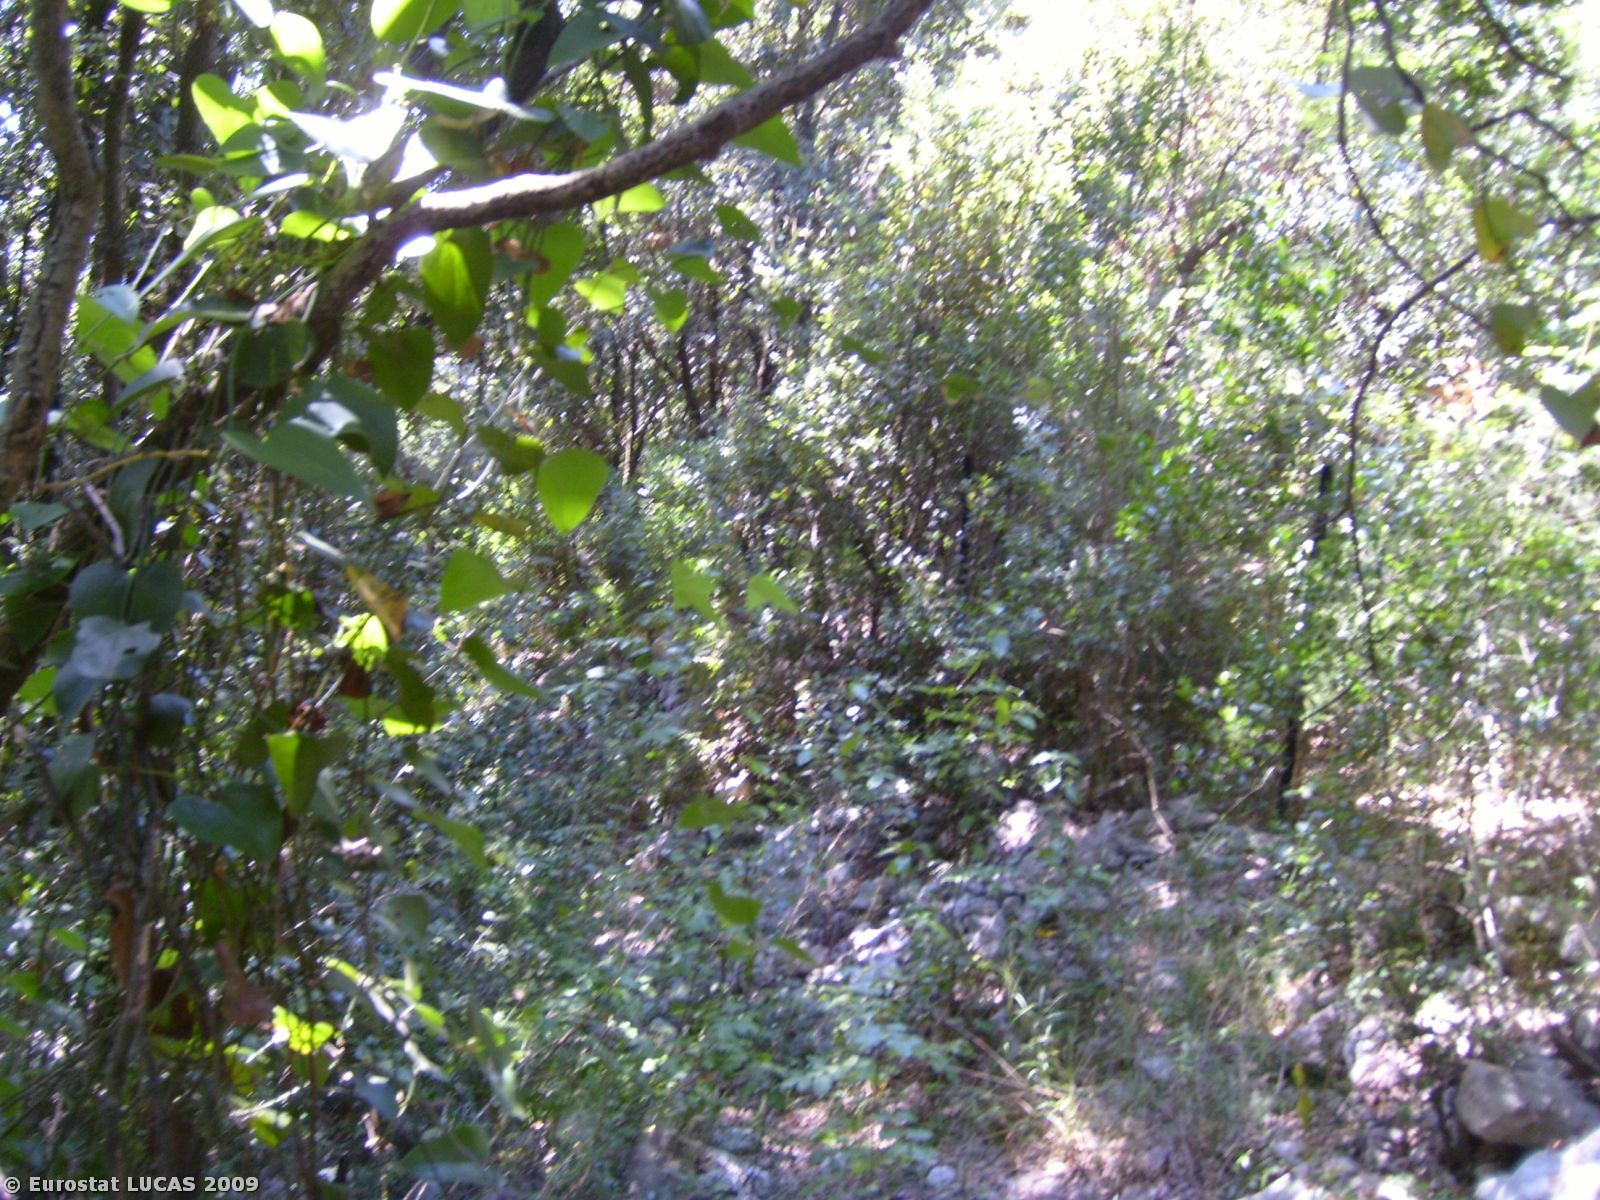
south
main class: Woodland
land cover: Broadleaved woodland
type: thermophilous deciduous forest
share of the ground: > 75 %
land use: Forestry
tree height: > 5 m
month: July
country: IT
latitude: 41.2221
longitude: 14.3372
